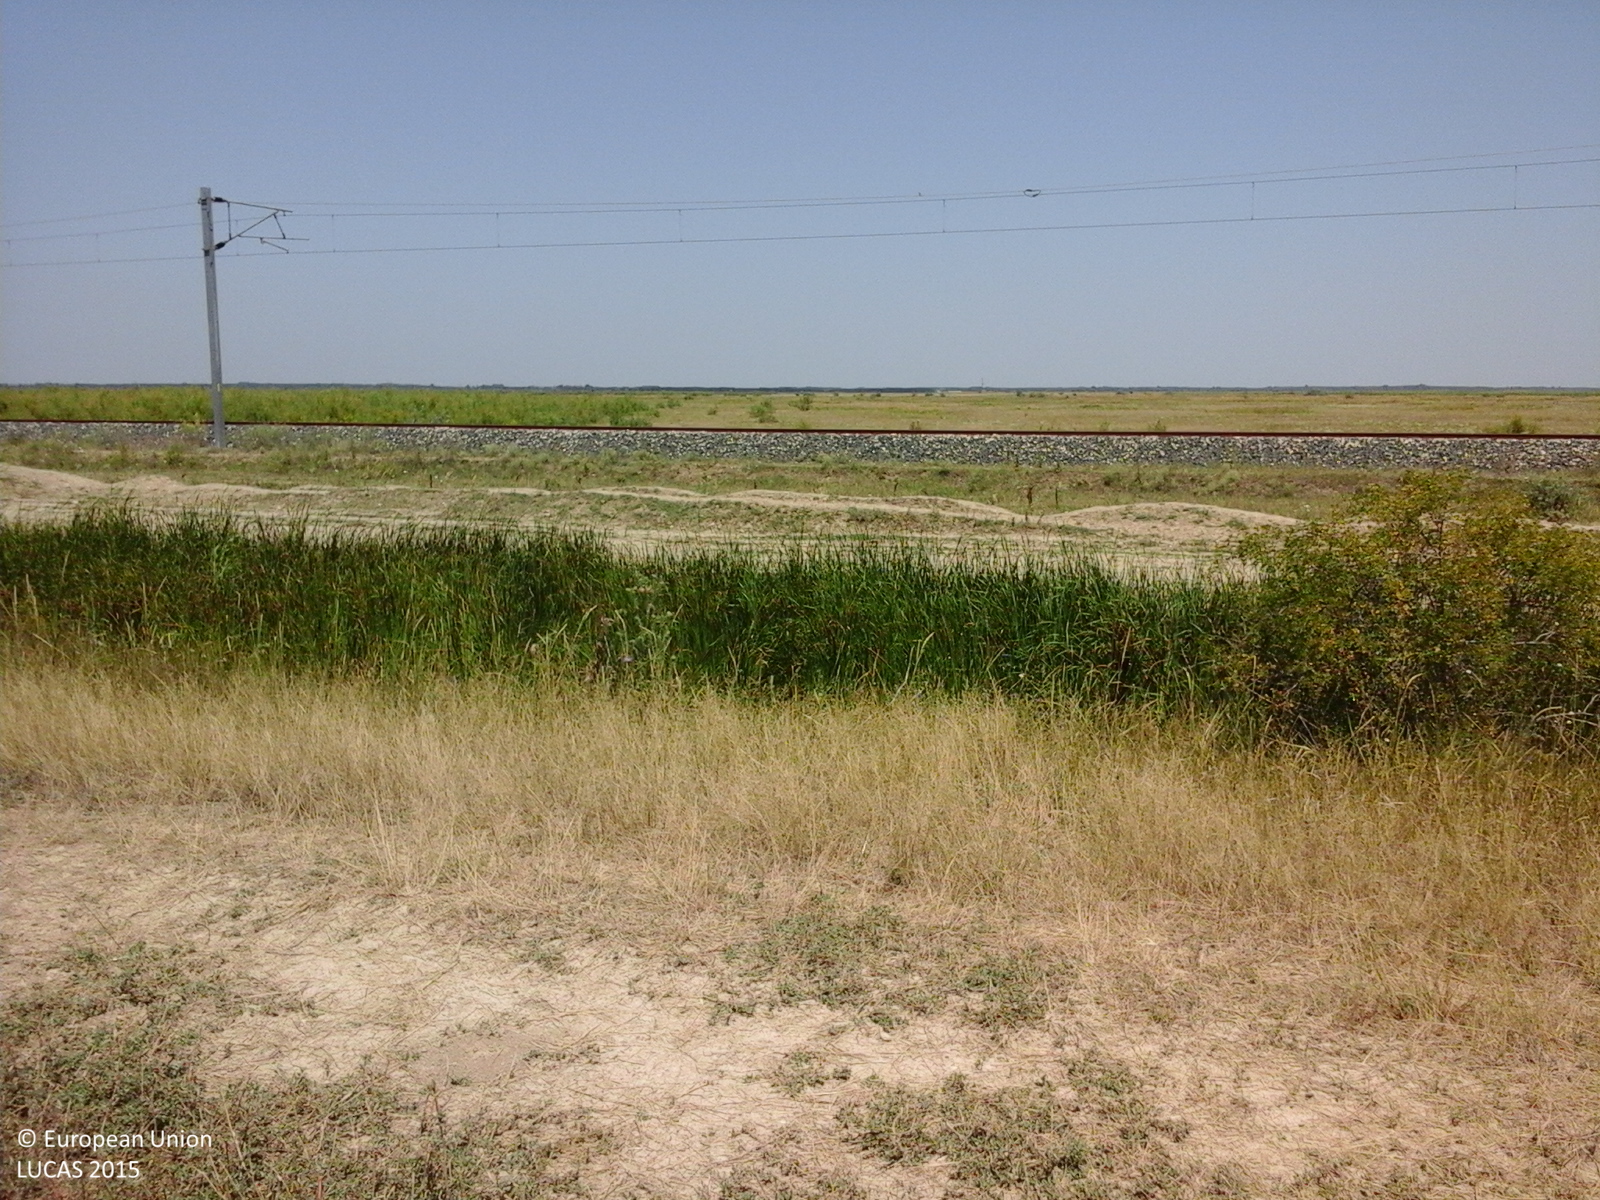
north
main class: Grassland
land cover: Spontaneously vegetated surfaces
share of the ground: > 75 %
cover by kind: herbaceous plants 100 %
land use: Fallow land
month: July
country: RO
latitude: 45.0733
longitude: 27.1993
